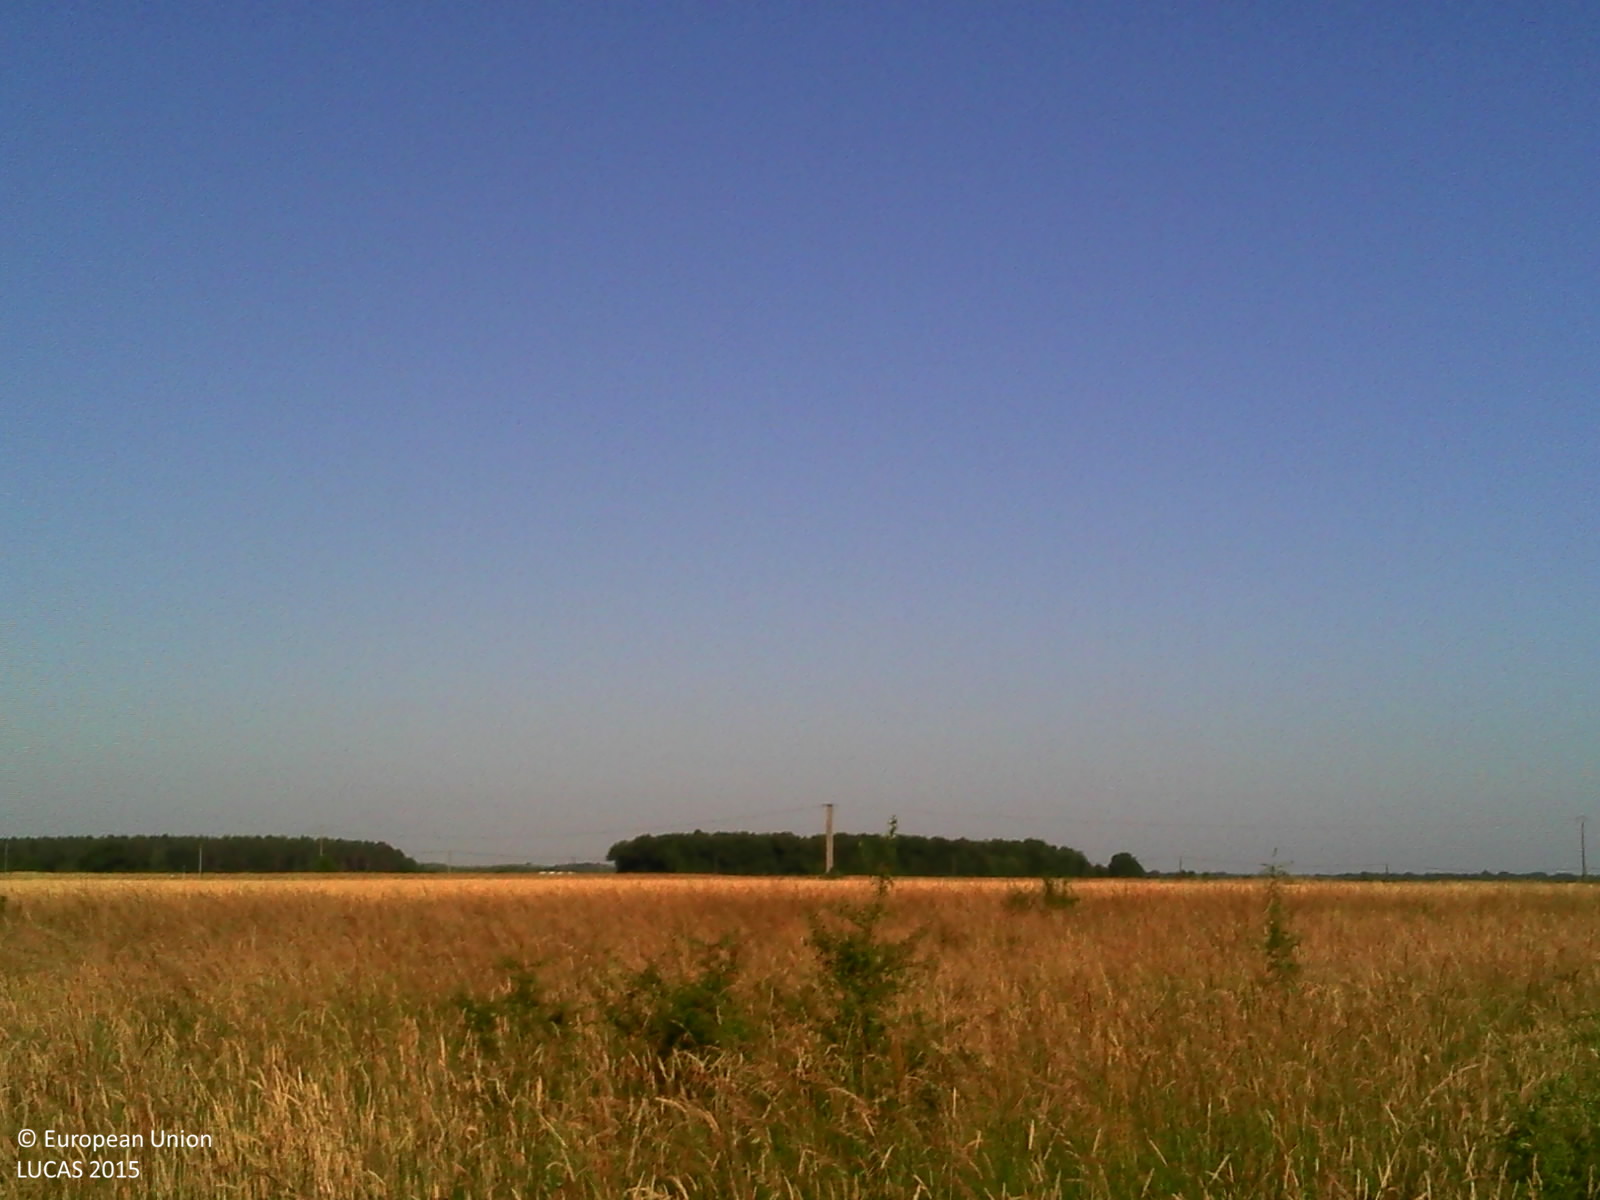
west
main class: Grassland
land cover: Grassland without tree/shrub cover
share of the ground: > 75 %
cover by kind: herbaceous plants 100 %
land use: Agriculture (excluding fallow land and kitchen gardens)
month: June
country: FR
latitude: 47.7714
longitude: 2.0222
